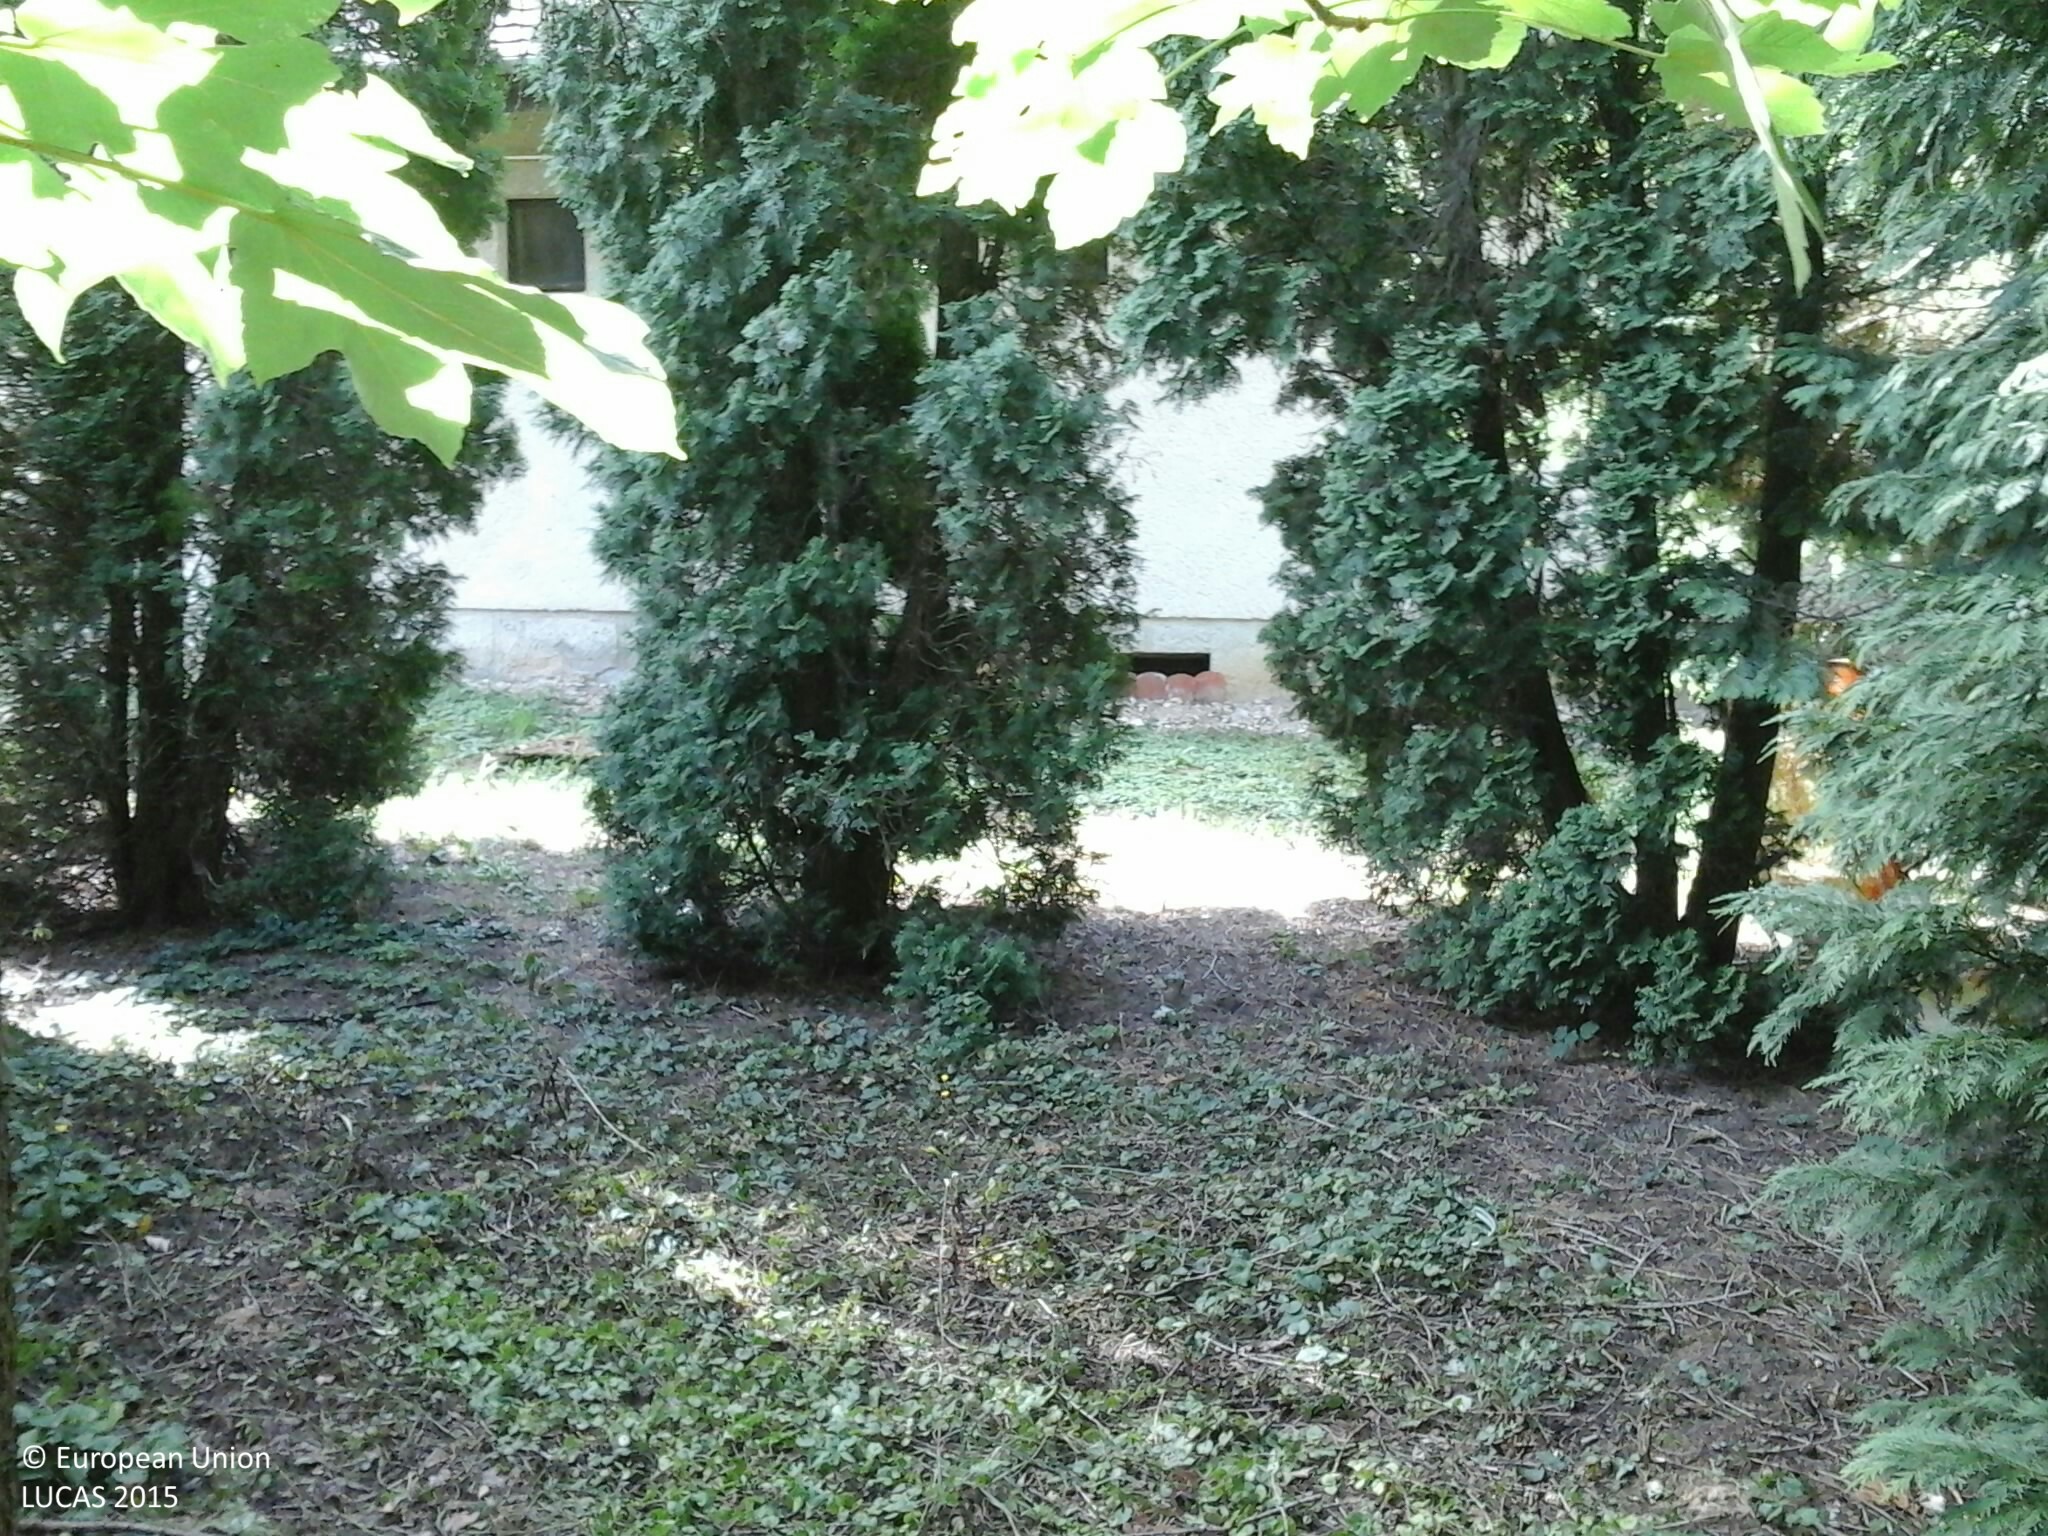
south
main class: Woodland
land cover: Broadleaved woodland
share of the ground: 50 - 75 %
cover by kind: broadleaved forest trees 70 %, herbaceous plants 25 %, coniferous forest trees 5 %
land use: Community services
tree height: > 5 m
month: August
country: HU
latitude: 46.8862
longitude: 16.6299
